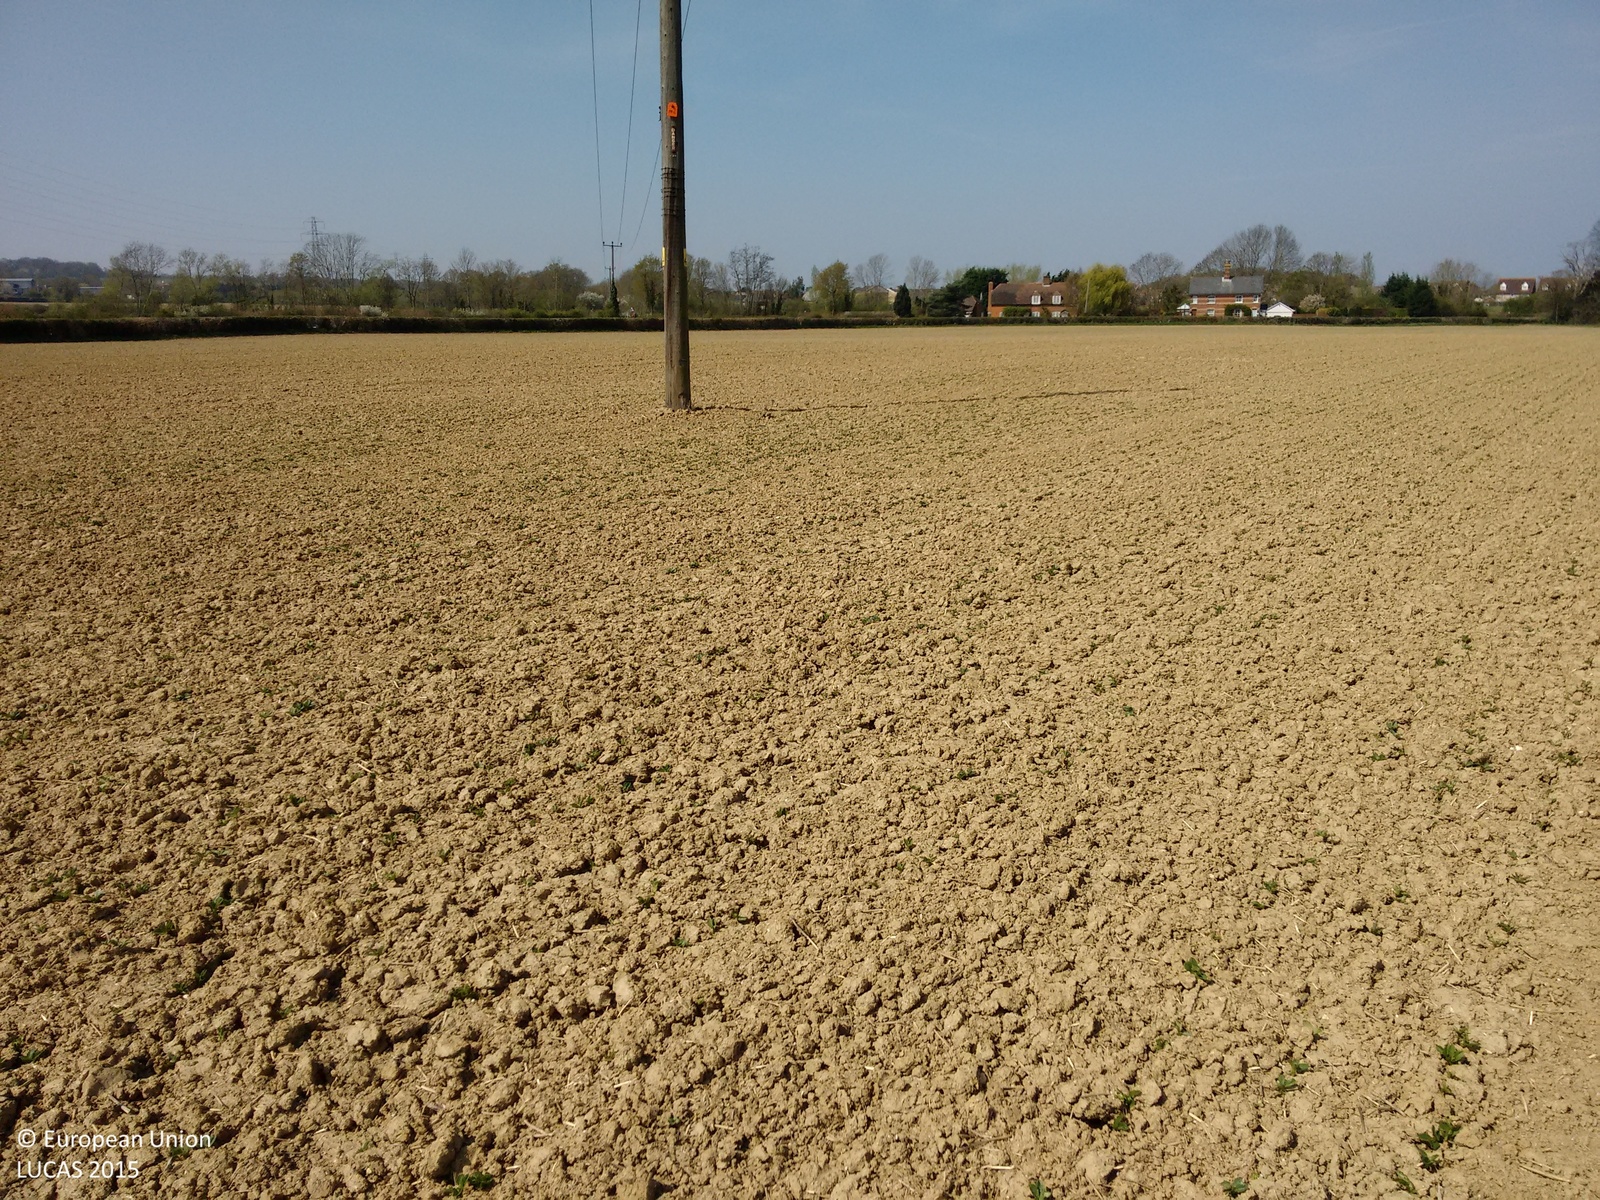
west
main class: Cropland
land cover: Dry pulses
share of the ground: < 10 %
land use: Agriculture (excluding fallow land and kitchen gardens)
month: April
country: GB
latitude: 51.1729
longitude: 0.4024
